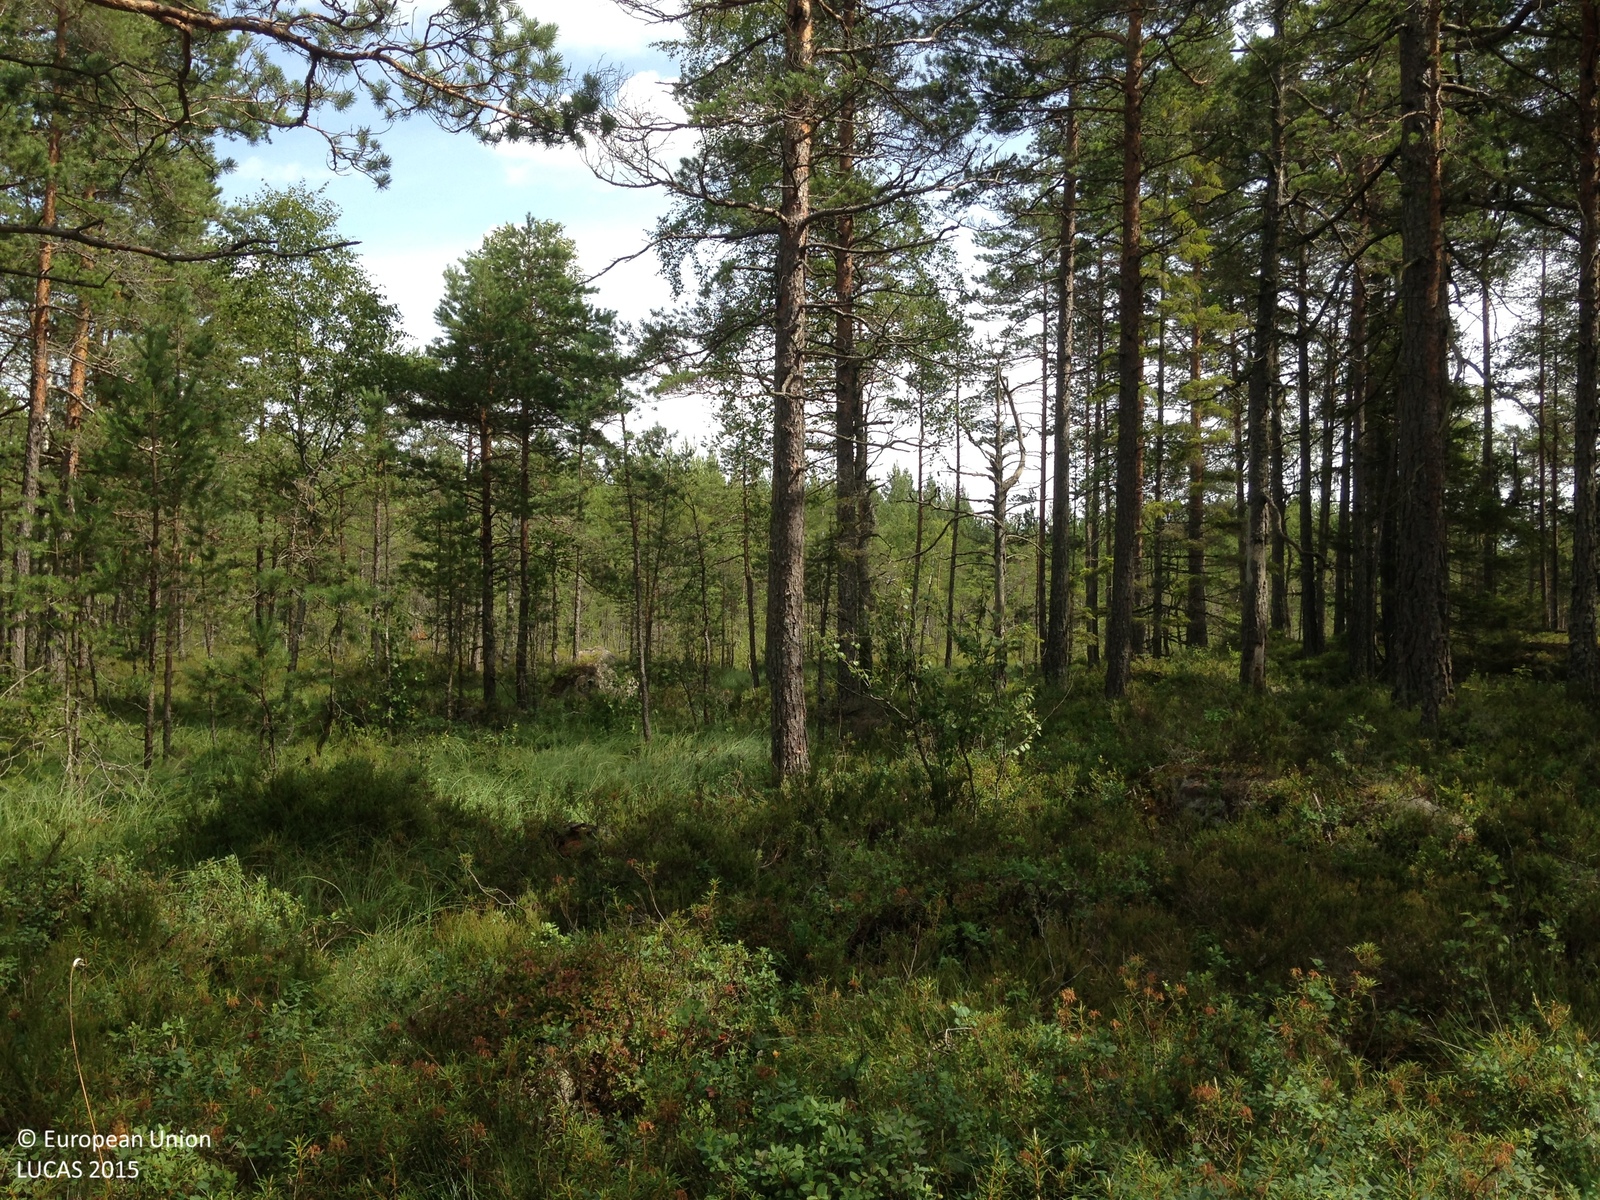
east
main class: Woodland
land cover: Pine dominated coniferous woodland
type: boreal forest
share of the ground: 10 - 25 %
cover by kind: shrubs 50 %, coniferous forest trees 20 %, lichens and mosses 20 %, herbaceous plants 10 %
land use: Forestry
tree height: > 5 m
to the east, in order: Pine dominated coniferous woodland
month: July
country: SE
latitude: 58.9744
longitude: 14.4627
